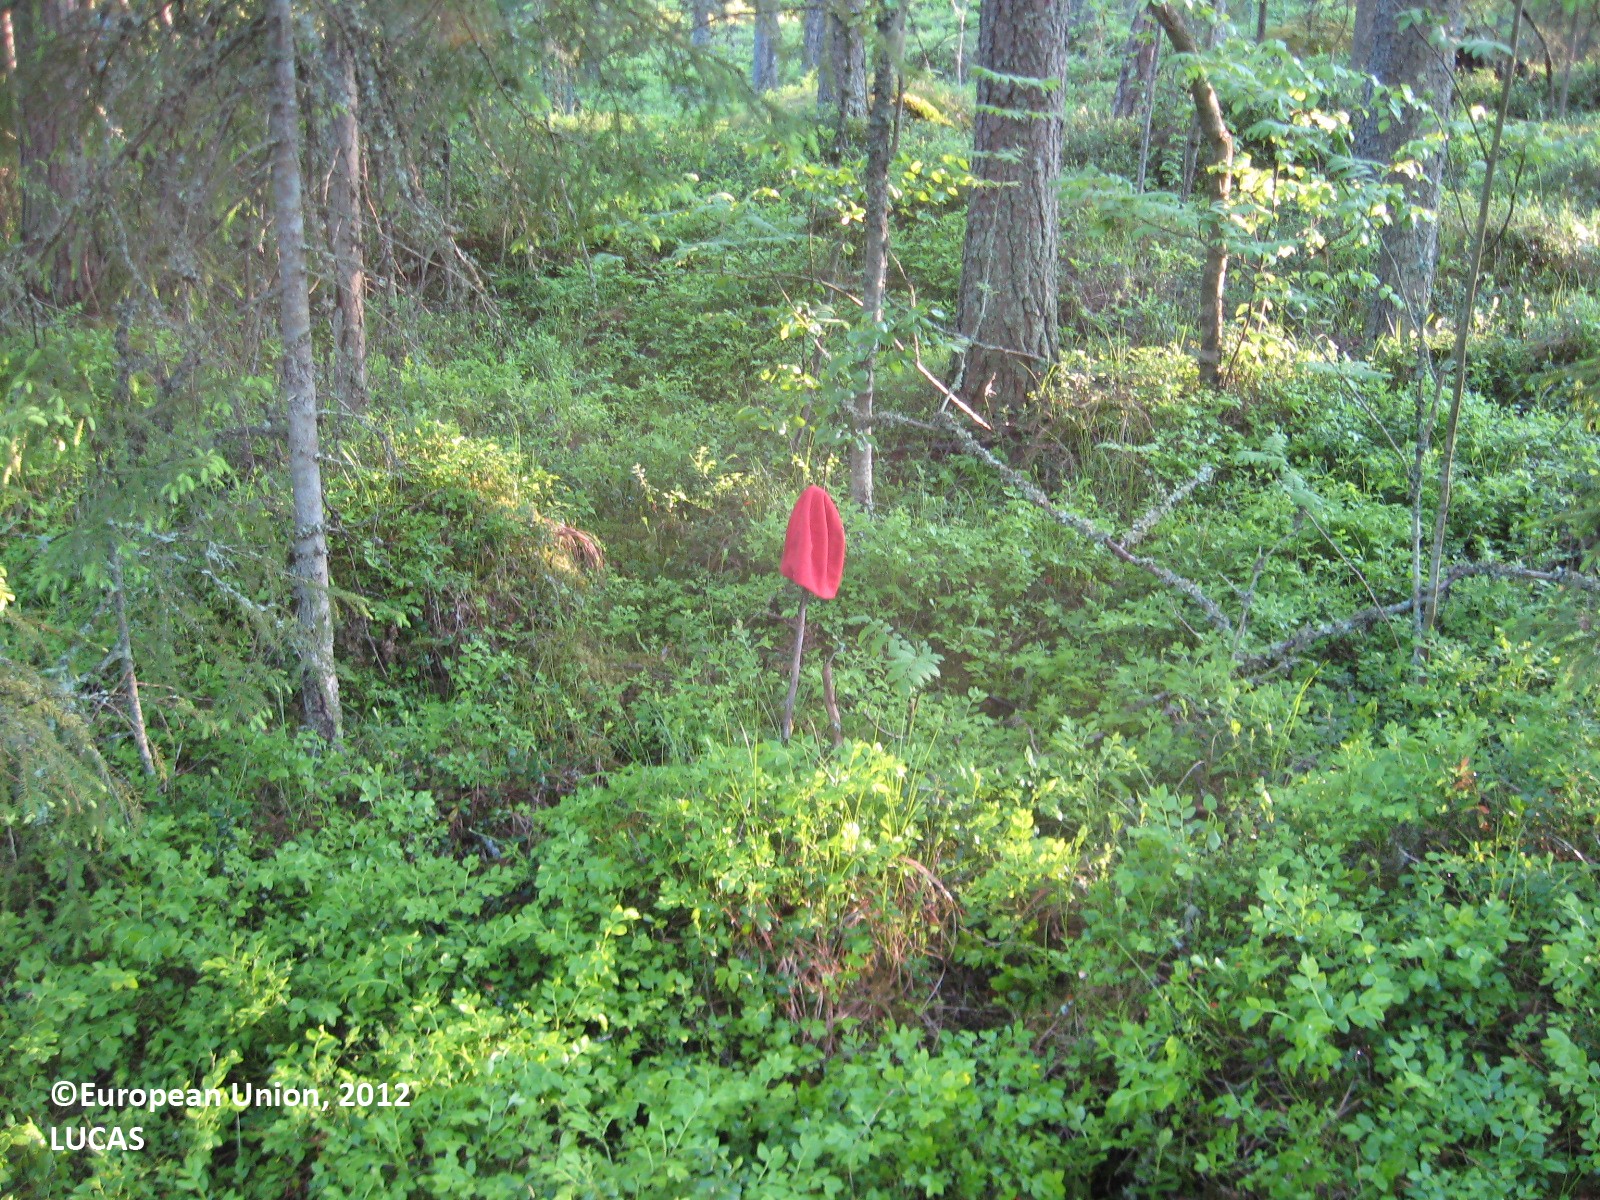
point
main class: Woodland
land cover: Spruce dominated coniferous woodland
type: boreal forest
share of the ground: > 75 %
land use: Forestry
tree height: > 5 m
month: June
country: FI
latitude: 63.1351
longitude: 22.6881
